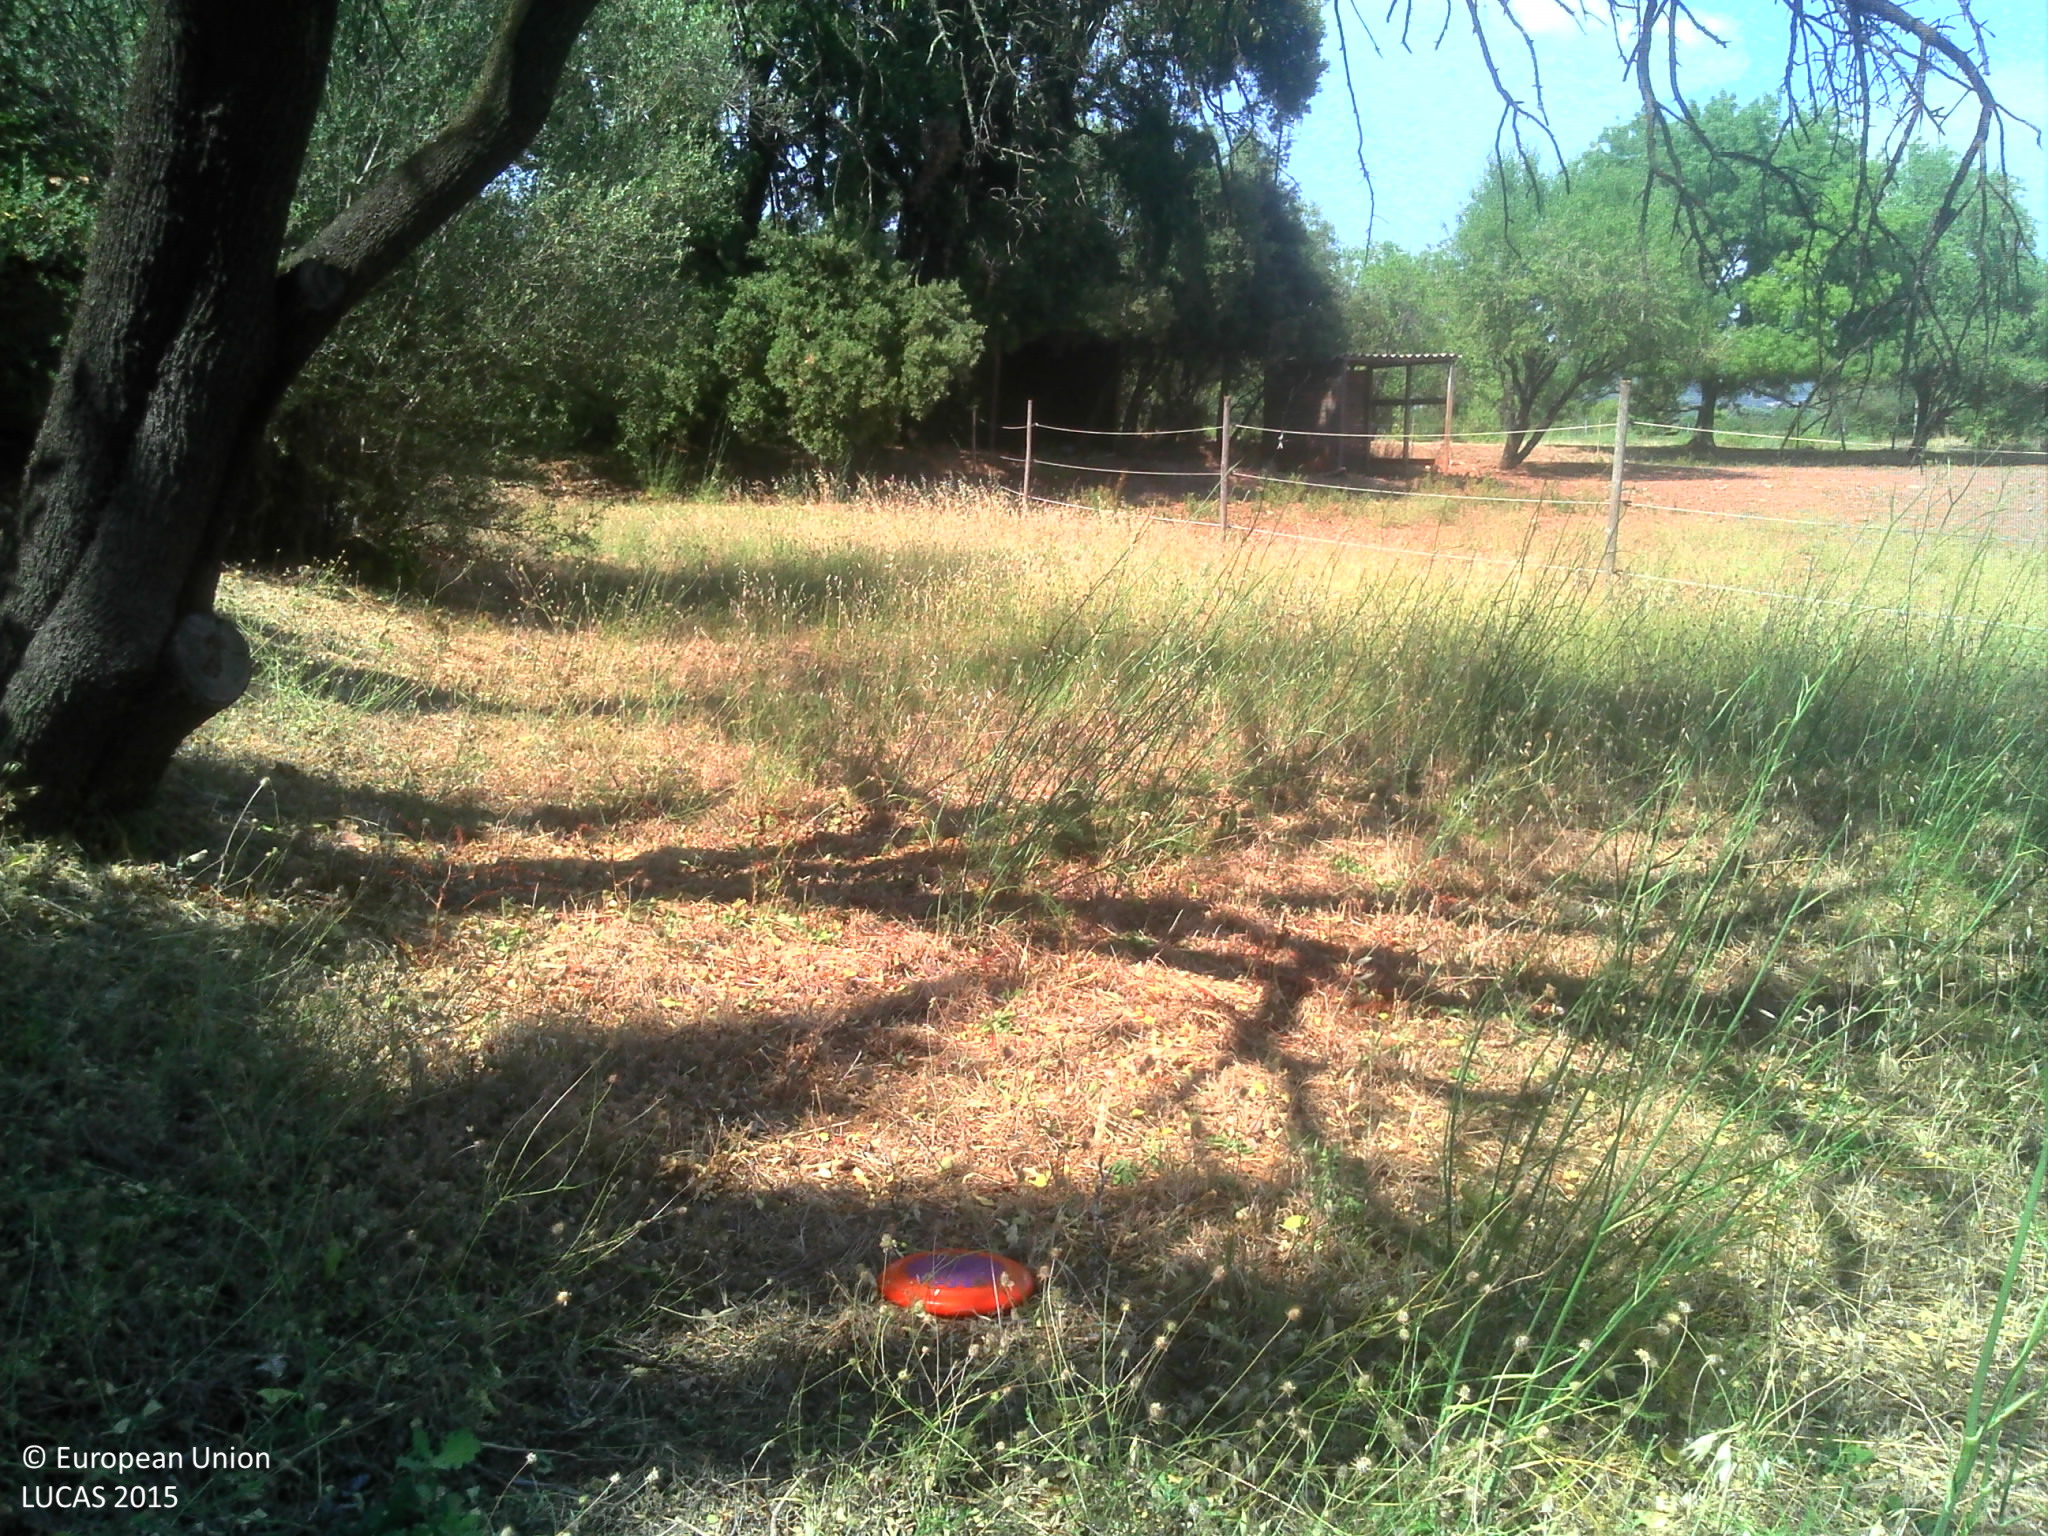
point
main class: Cropland
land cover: Nuts trees
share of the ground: < 10 %
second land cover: Grassland without tree/shrub cover
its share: > 75 %
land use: Kitchen garden
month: July
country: FR
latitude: 43.3634
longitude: 6.2949
